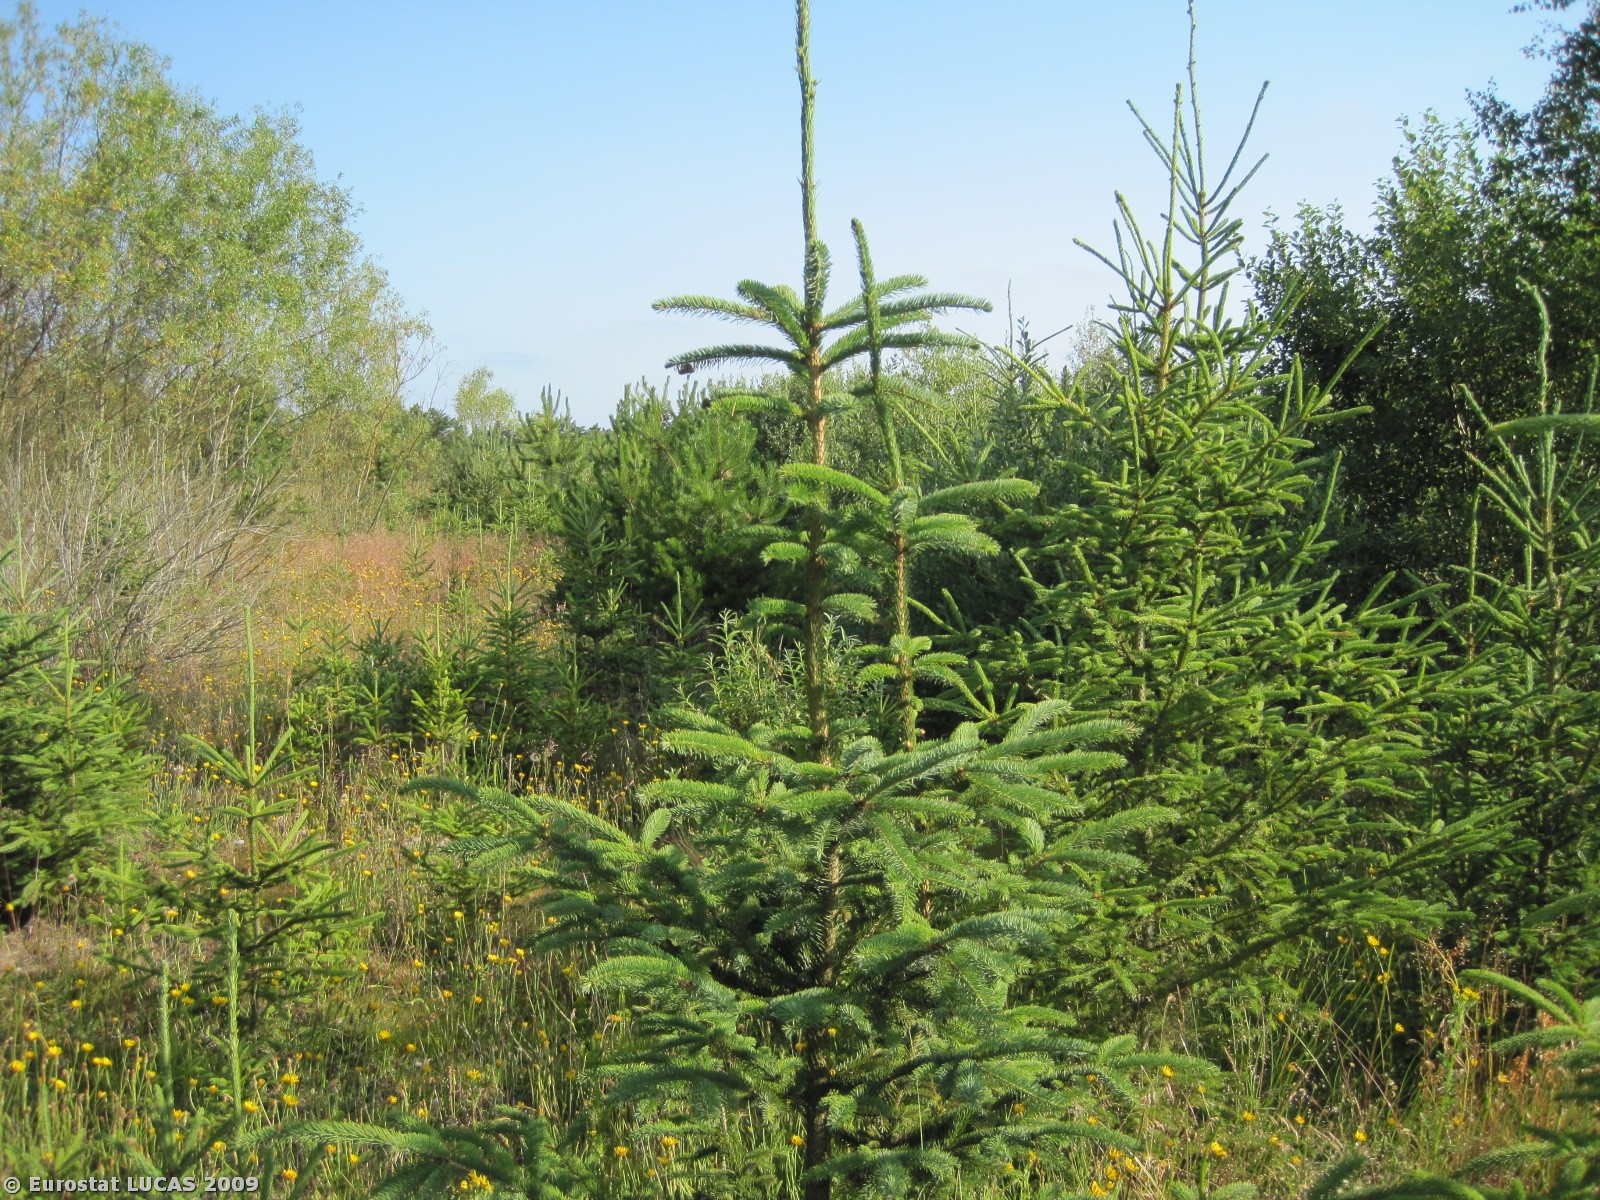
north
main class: Woodland
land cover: Mixed woodland
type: plantations and self-sown exotic forest
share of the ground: 25 - 50 %
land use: Forestry
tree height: > 5 m
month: July
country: DK
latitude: 56.4873
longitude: 8.7511
